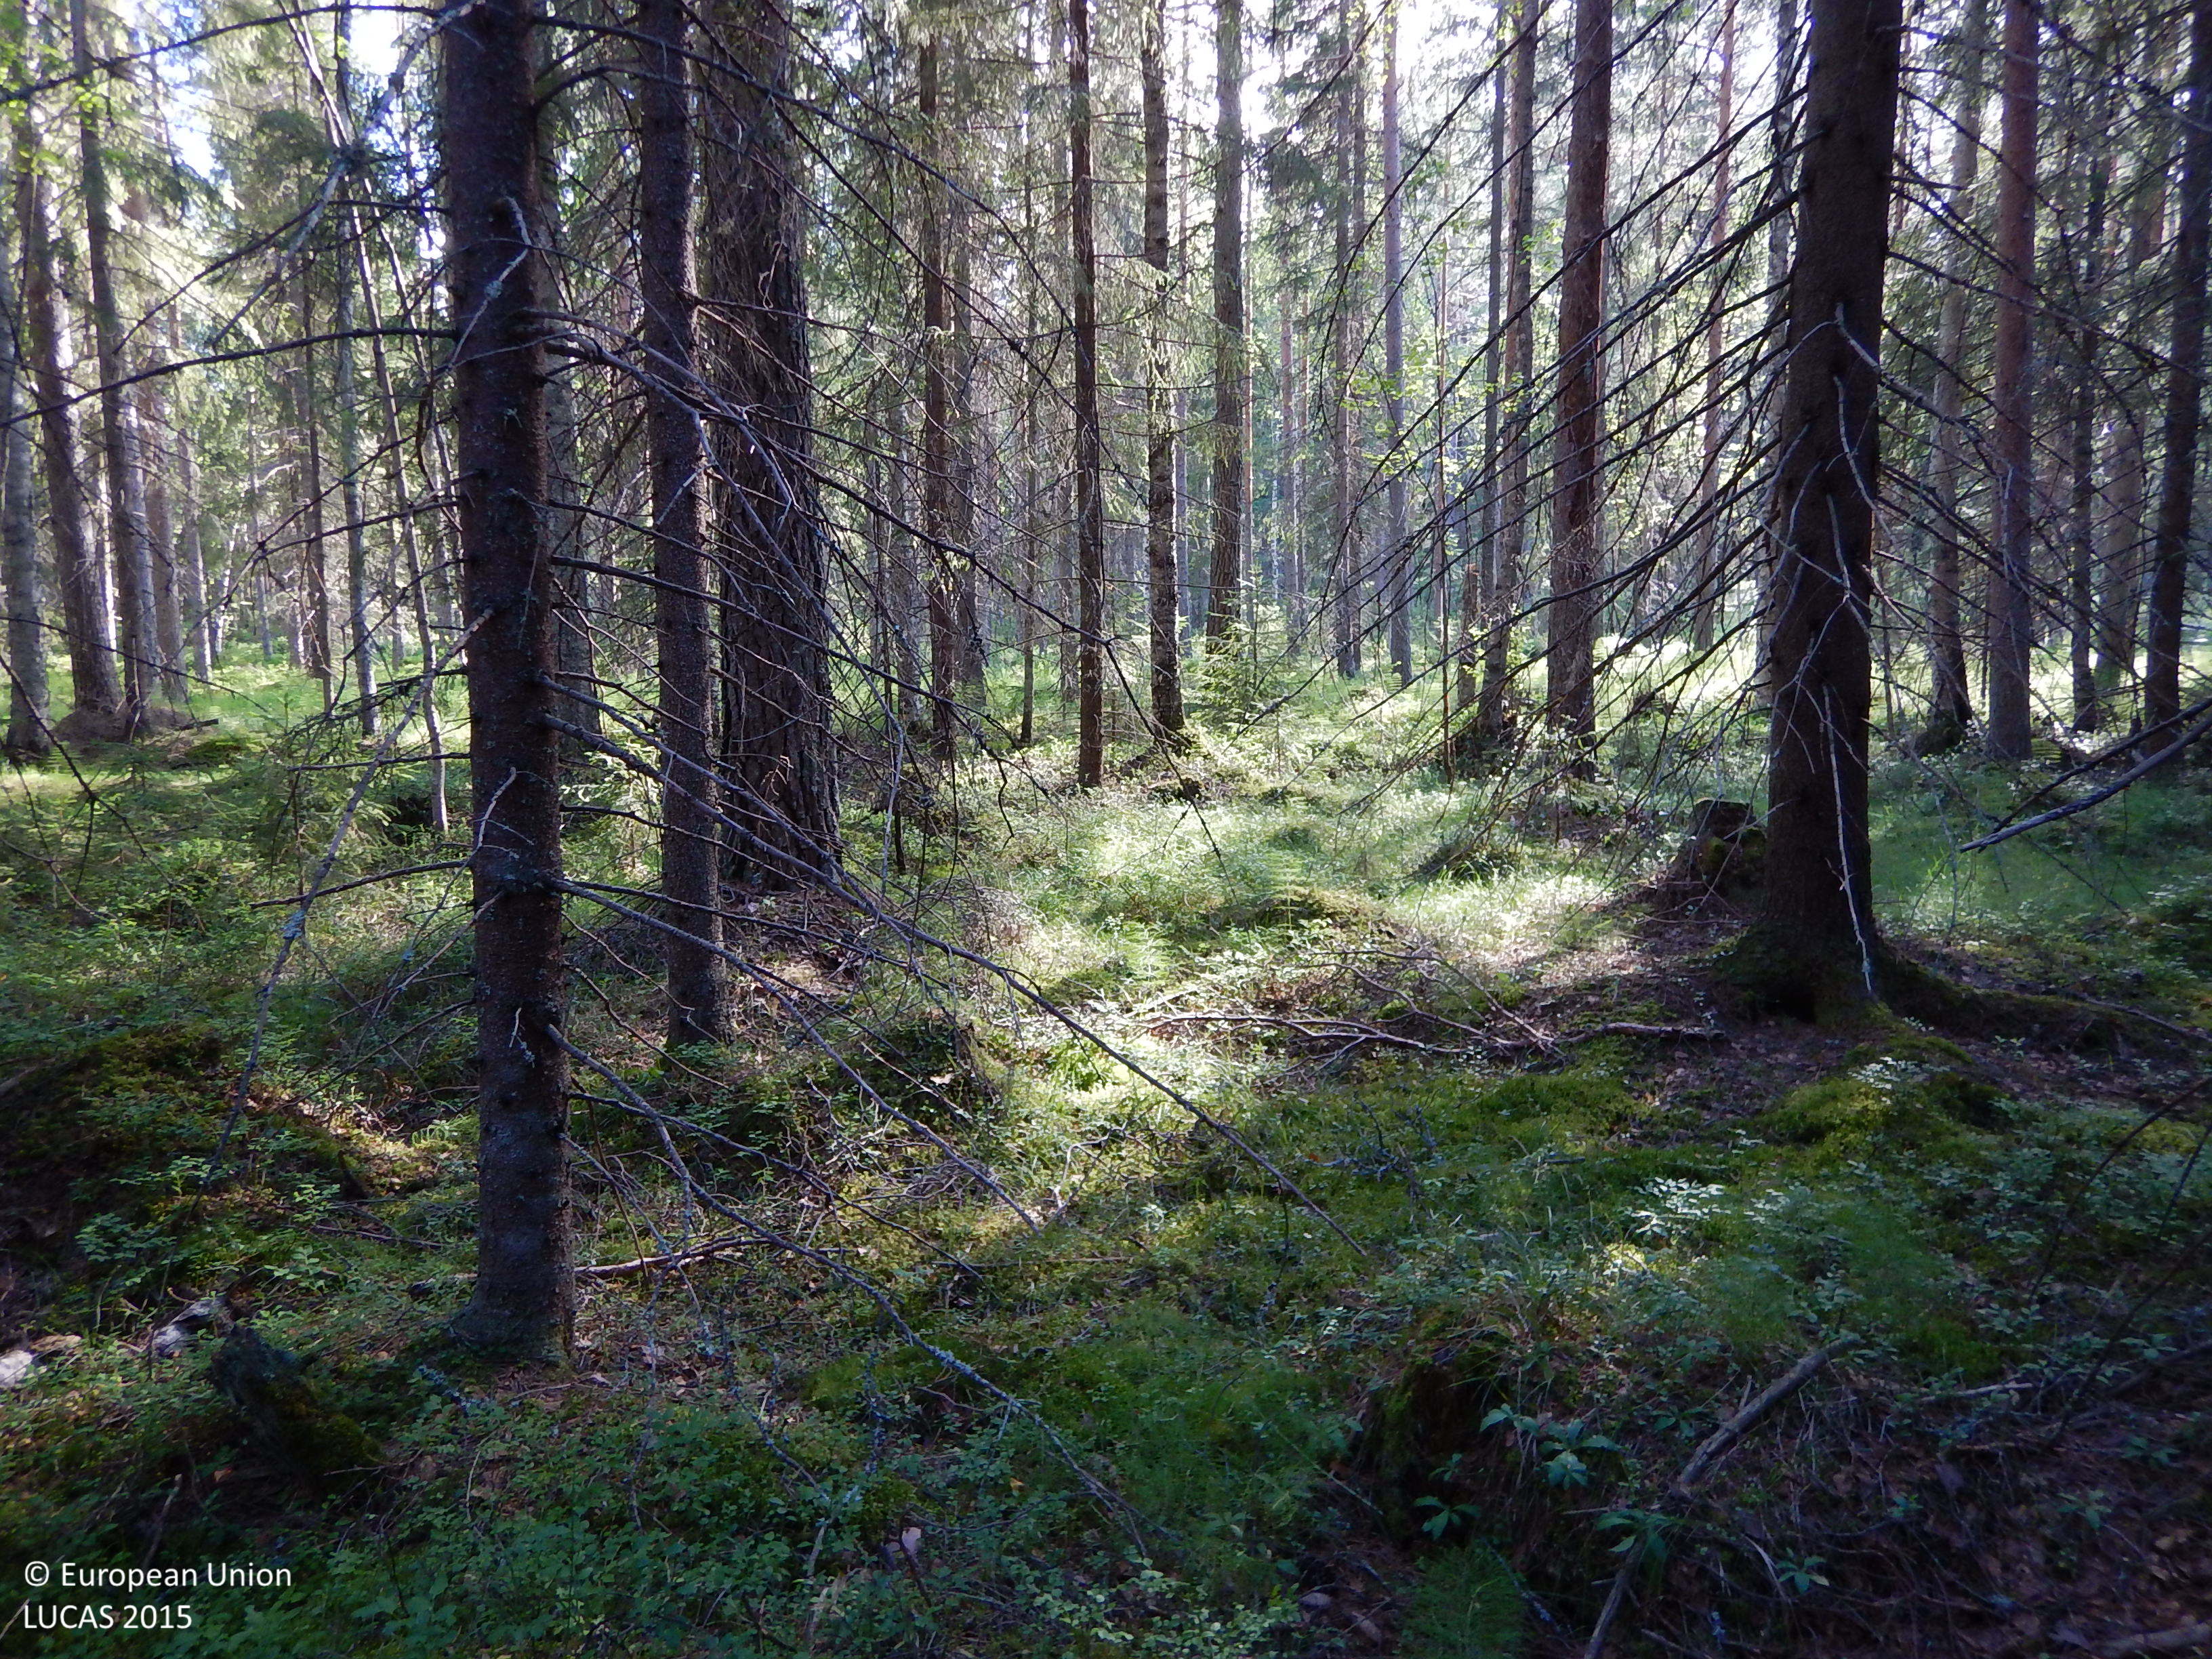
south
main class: Woodland
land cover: Spruce dominated coniferous woodland
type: boreal forest
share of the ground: 50 - 75 %
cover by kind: coniferous forest trees 55 %, lichens and mosses 20 %, broadleaved forest trees 10 %, shrubs 10 %, herbaceous plants 5 %
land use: Forestry
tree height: > 5 m
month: July
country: SE
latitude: 64.8015
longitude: 20.9872
